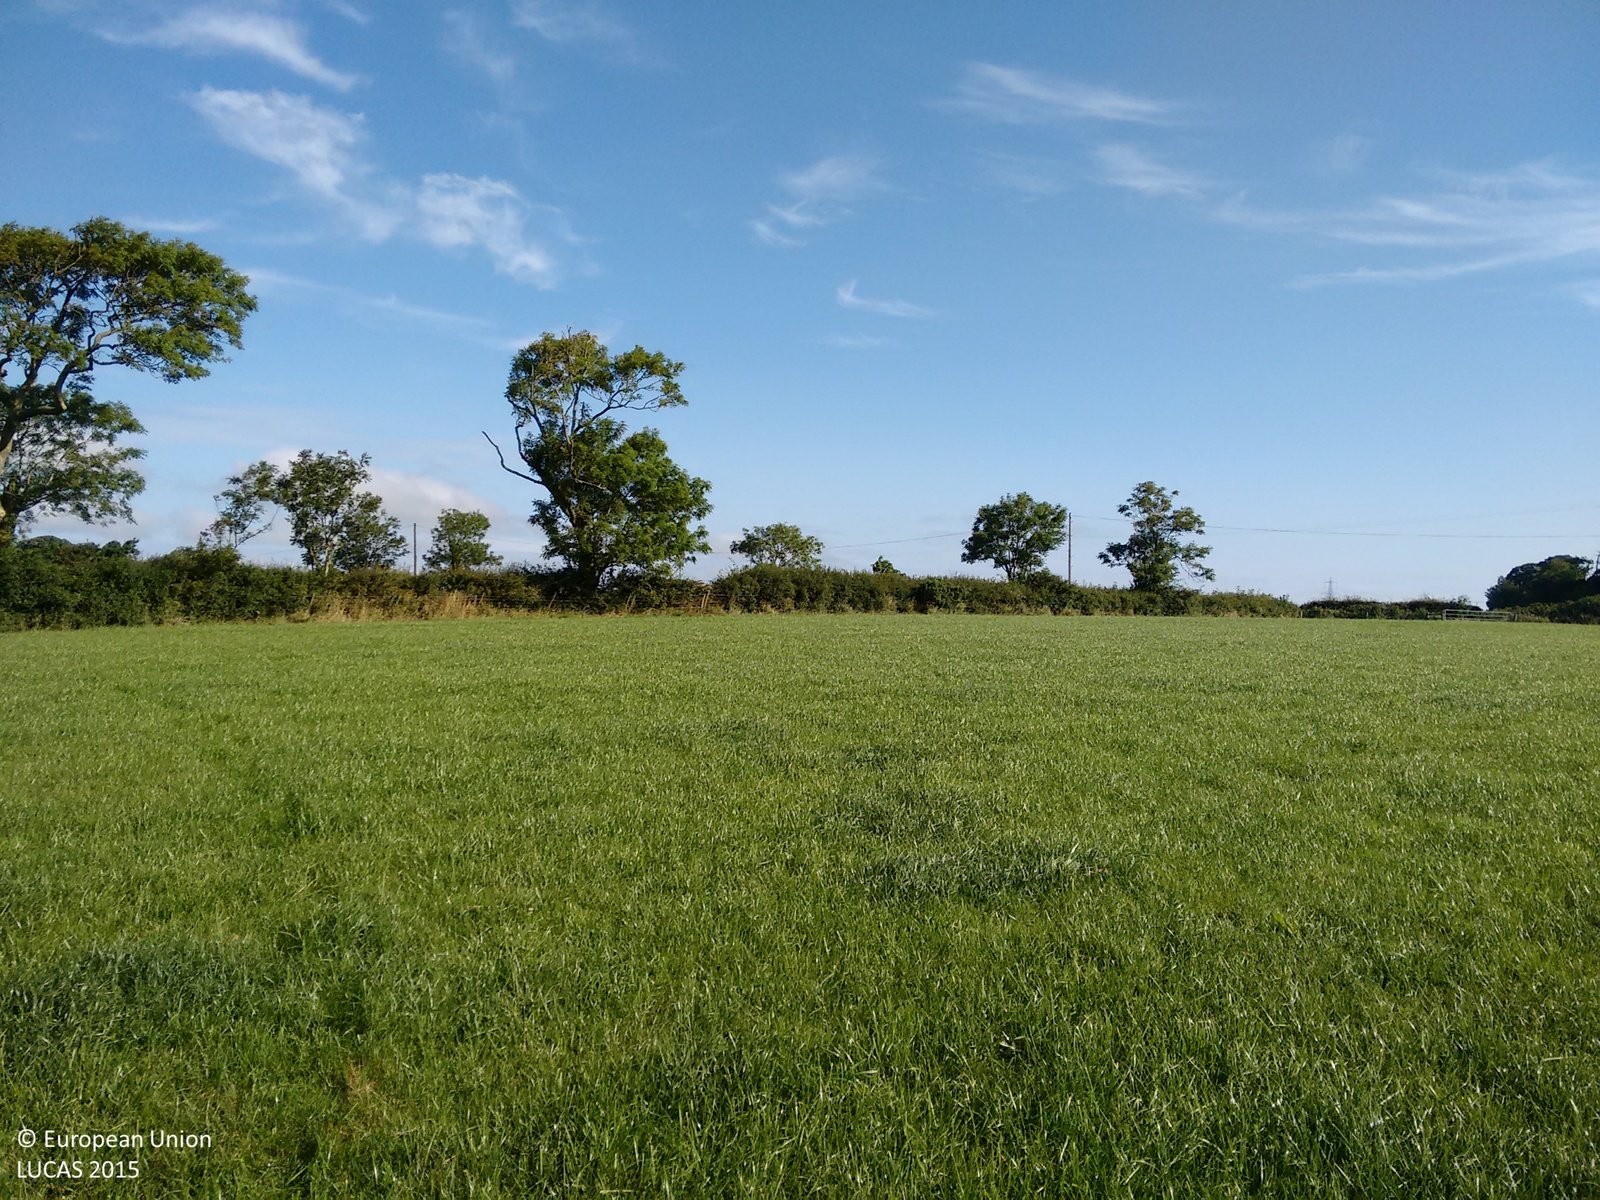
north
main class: Grassland
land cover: Grassland without tree/shrub cover
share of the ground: > 75 %
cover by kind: herbaceous plants 100 %
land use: Agriculture (excluding fallow land and kitchen gardens)
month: August
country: GB
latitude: 53.2955
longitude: -4.3088
